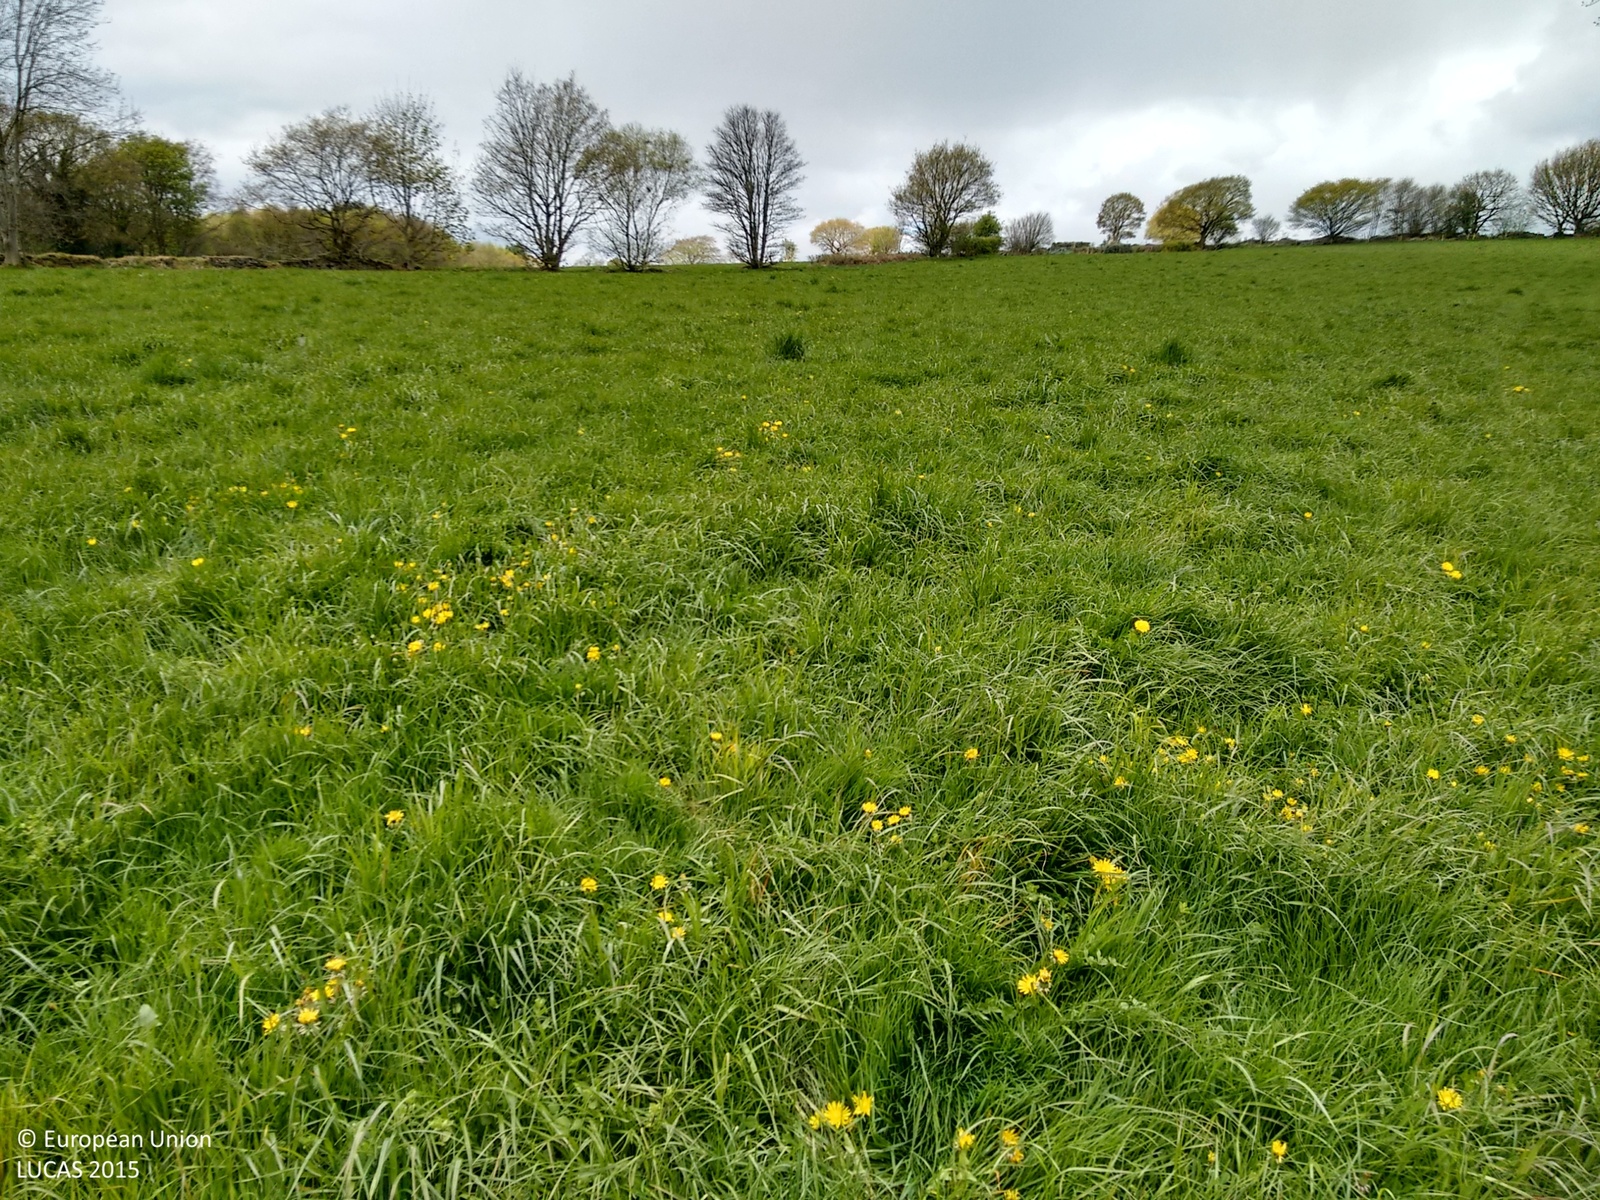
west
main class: Grassland
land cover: Grassland without tree/shrub cover
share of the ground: > 75 %
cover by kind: herbaceous plants 100 %
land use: Agriculture (excluding fallow land and kitchen gardens)
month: April
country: GB
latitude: 53.5837
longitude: -1.6377
